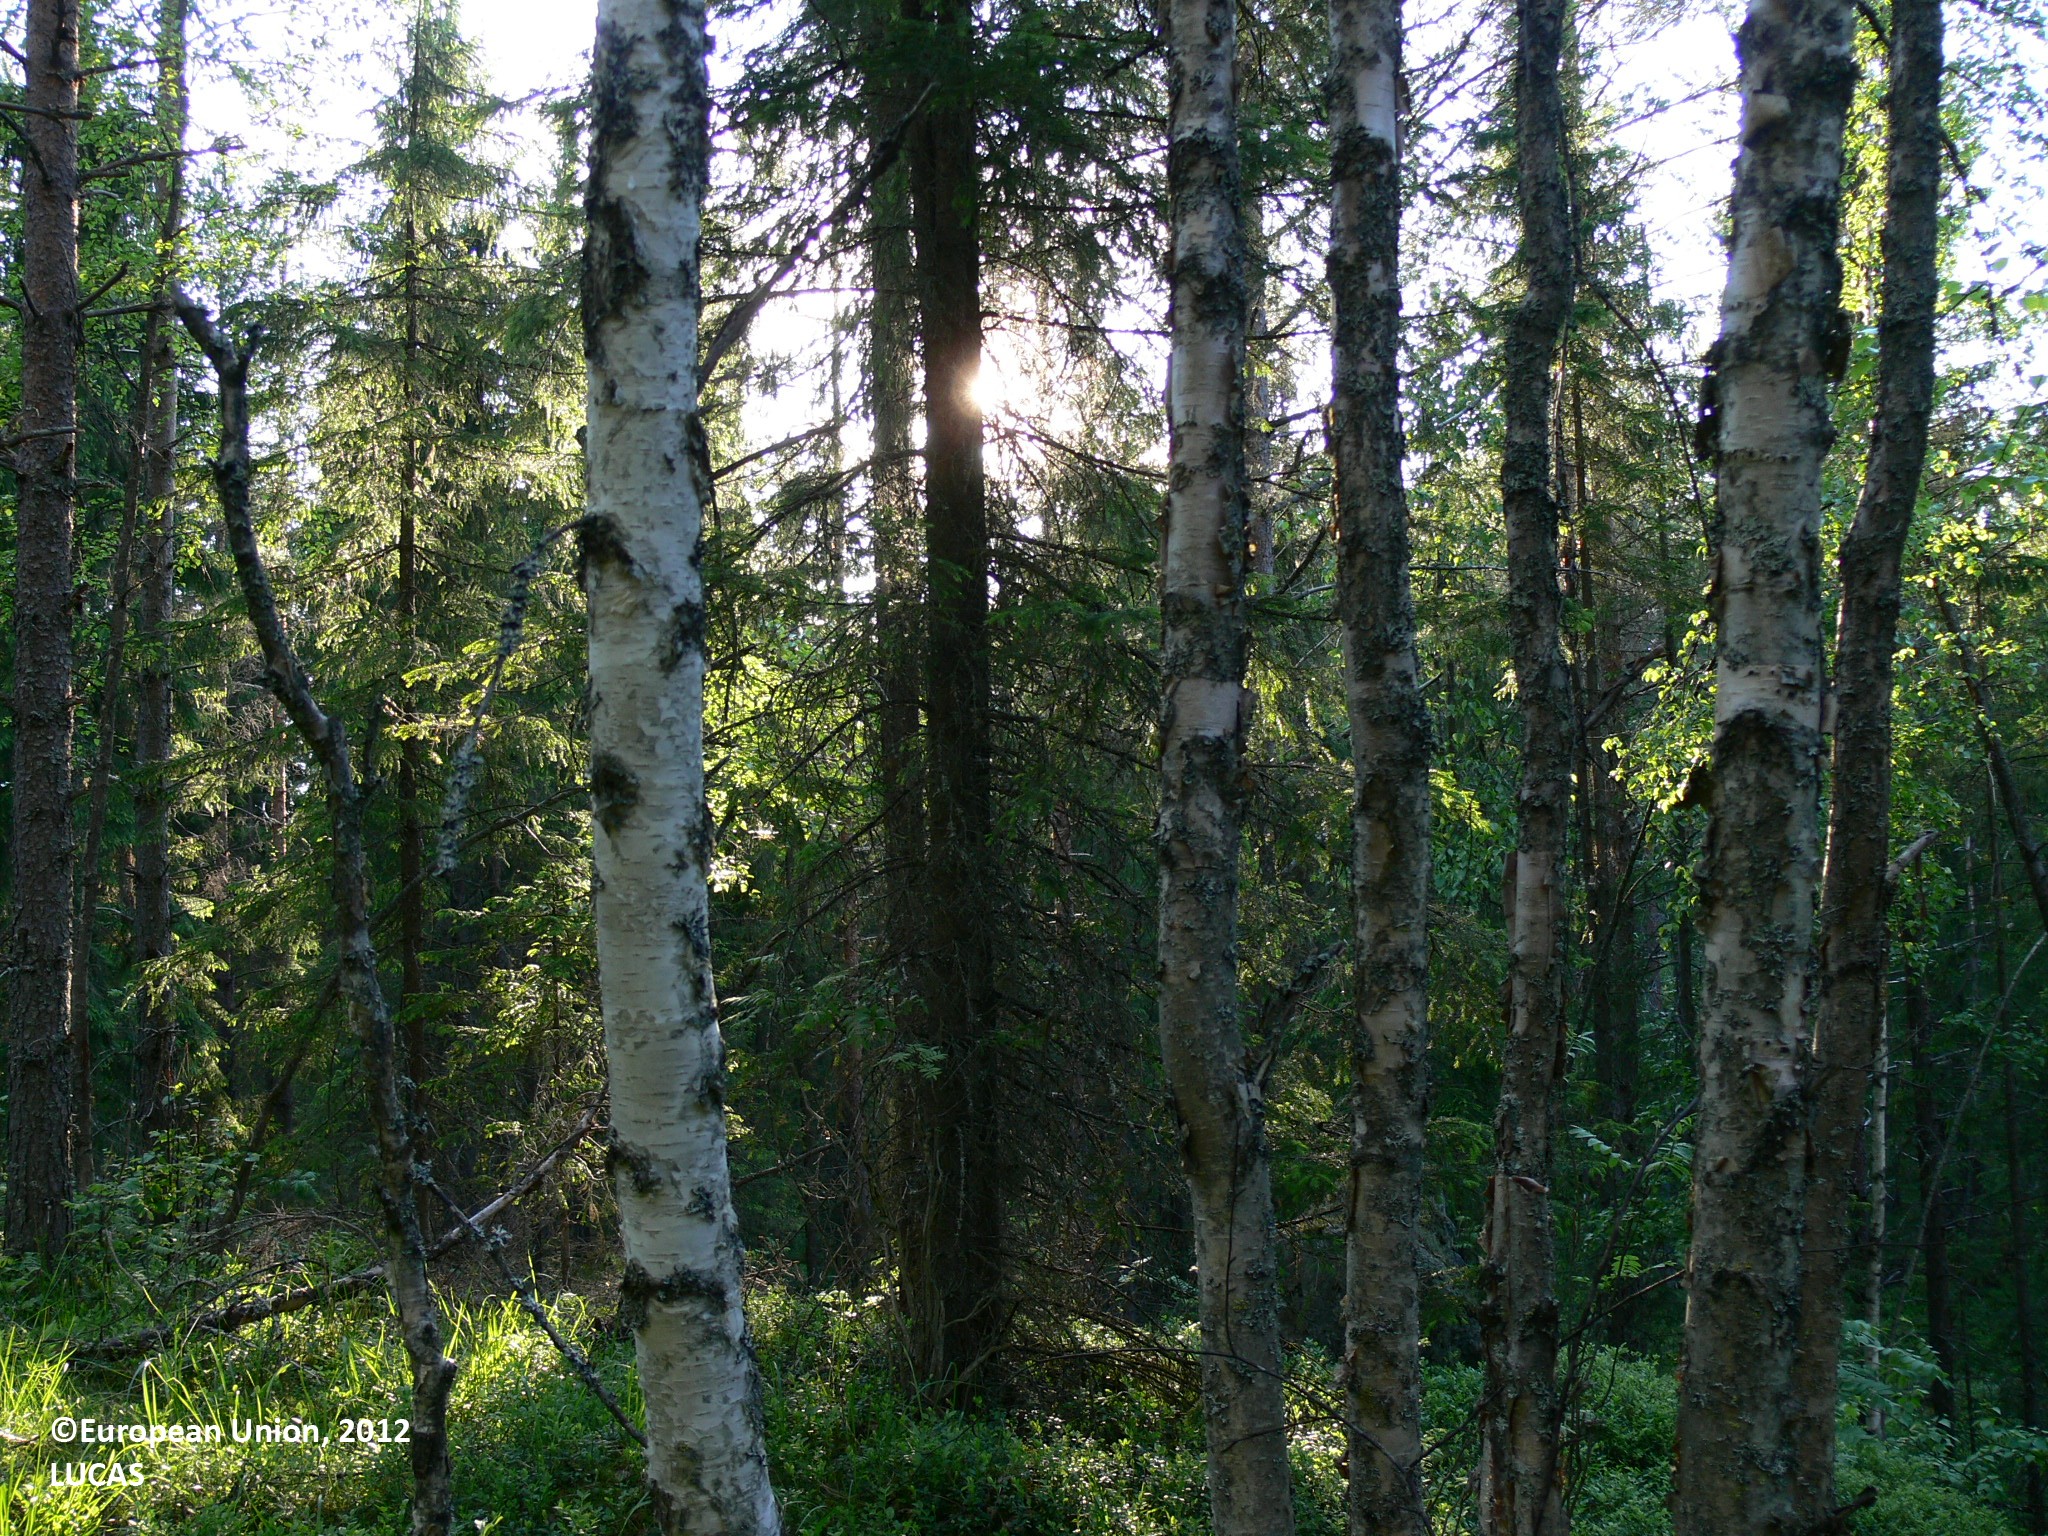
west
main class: Woodland
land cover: Other mixed woodland
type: boreal forest
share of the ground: > 75 %
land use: Forestry
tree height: > 5 m
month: June
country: FI
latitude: 62.2882
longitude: 30.5867
